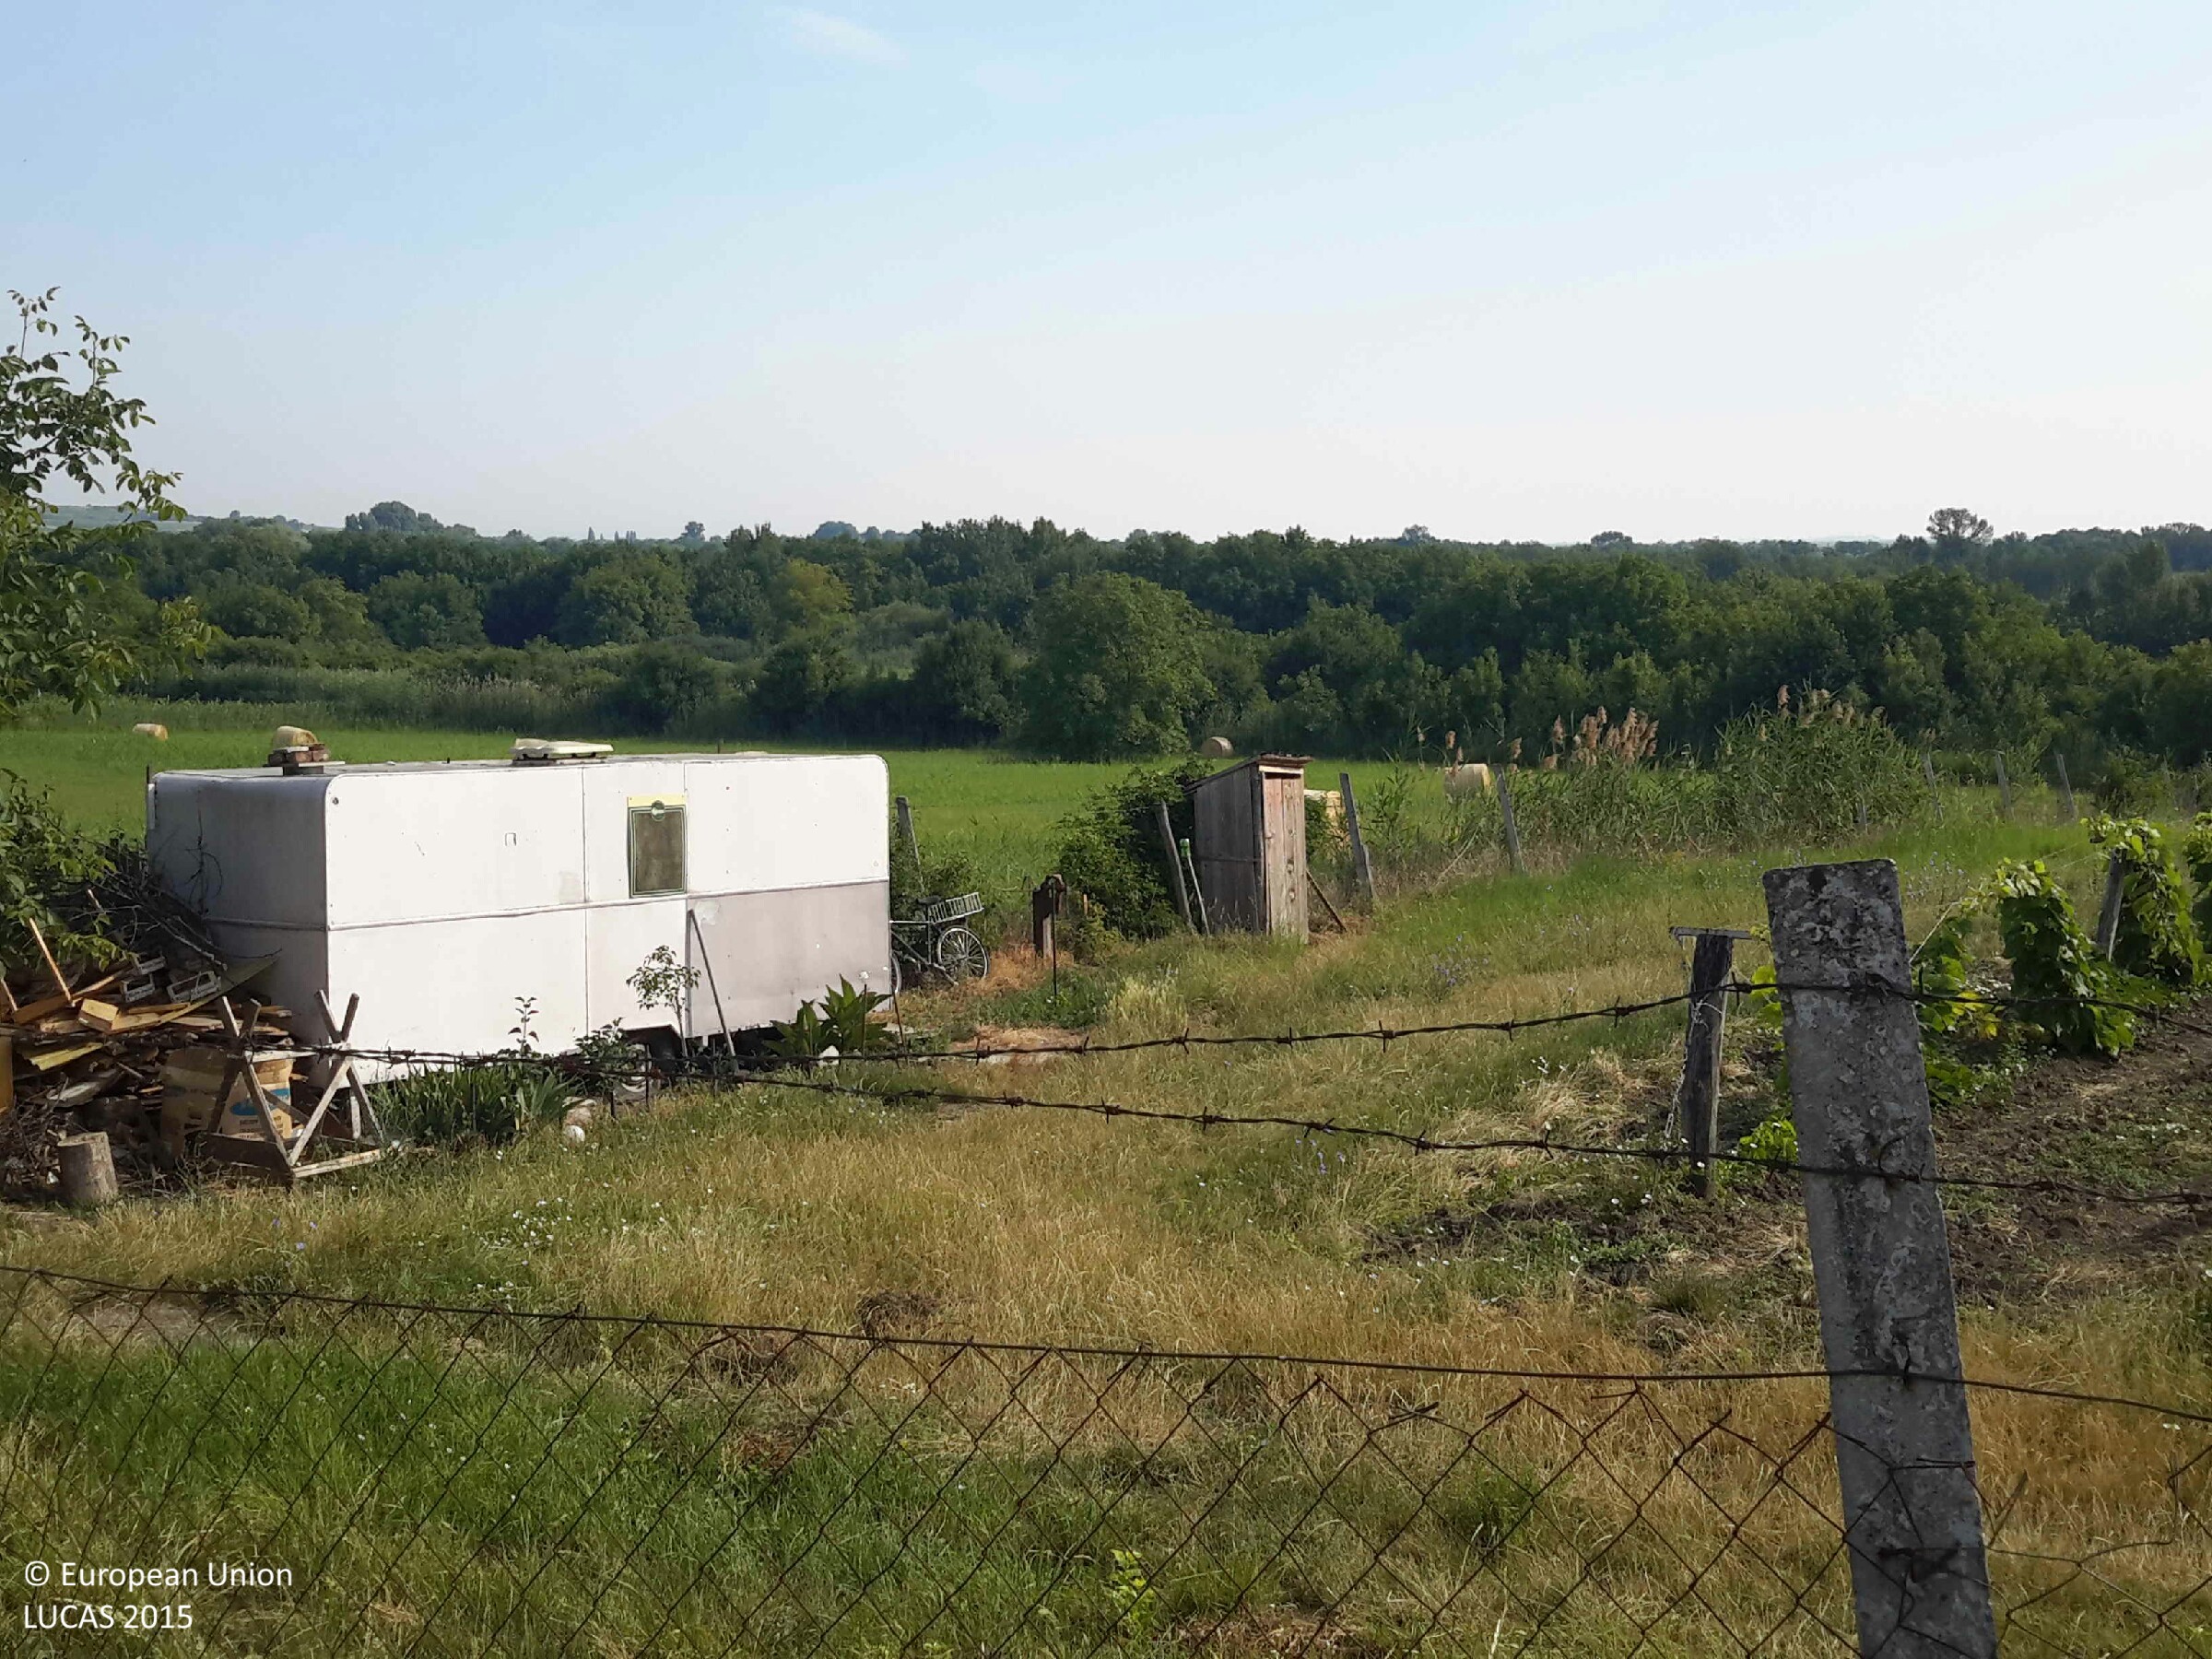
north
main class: Cropland
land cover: Vineyards
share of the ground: < 10 %
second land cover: Other bare soil
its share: > 75 %
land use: Agriculture (excluding fallow land and kitchen gardens)
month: July
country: HU
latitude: 47.6421
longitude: 16.6736
